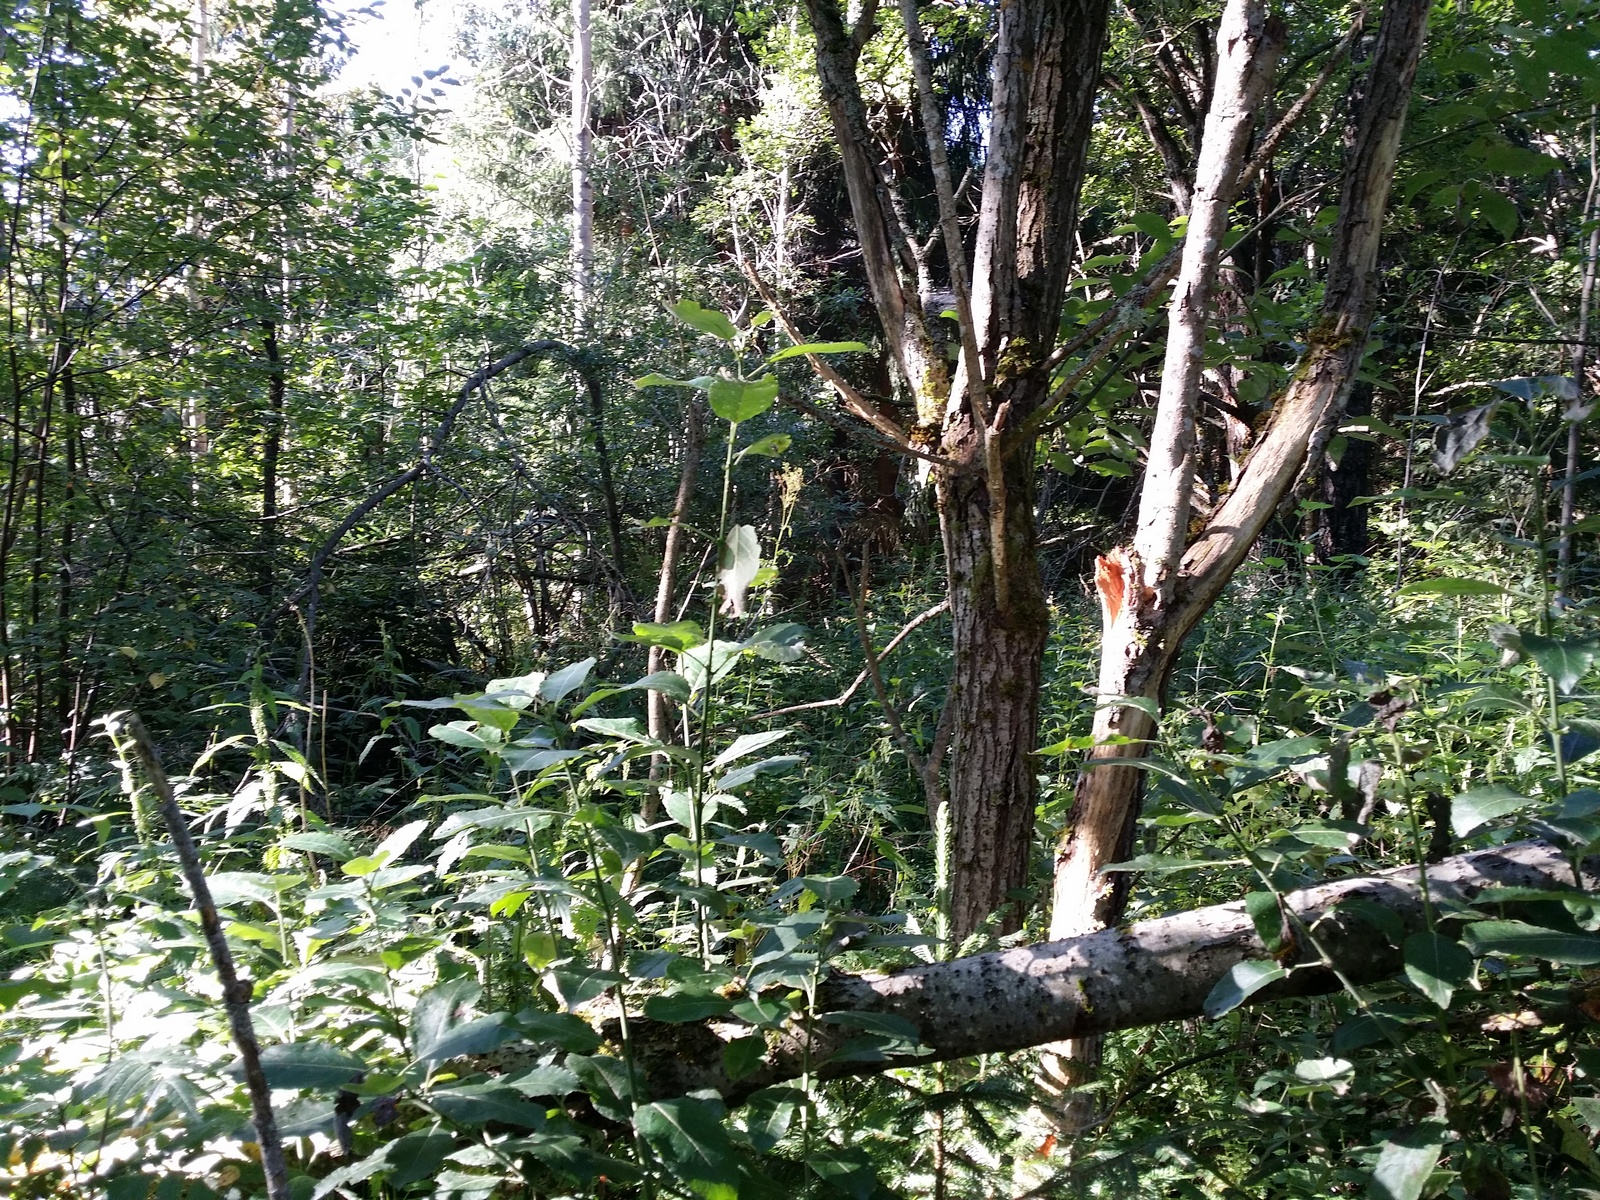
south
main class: Woodland
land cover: Broadleaved woodland
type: non-riverine alder, birch or aspen forest
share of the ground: > 75 %
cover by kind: broadleaved forest trees 75 %, shrubs 20 %, coniferous forest trees 5 %
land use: Forestry
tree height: > 5 m
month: August
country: LV
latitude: 56.9084
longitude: 27.6388
